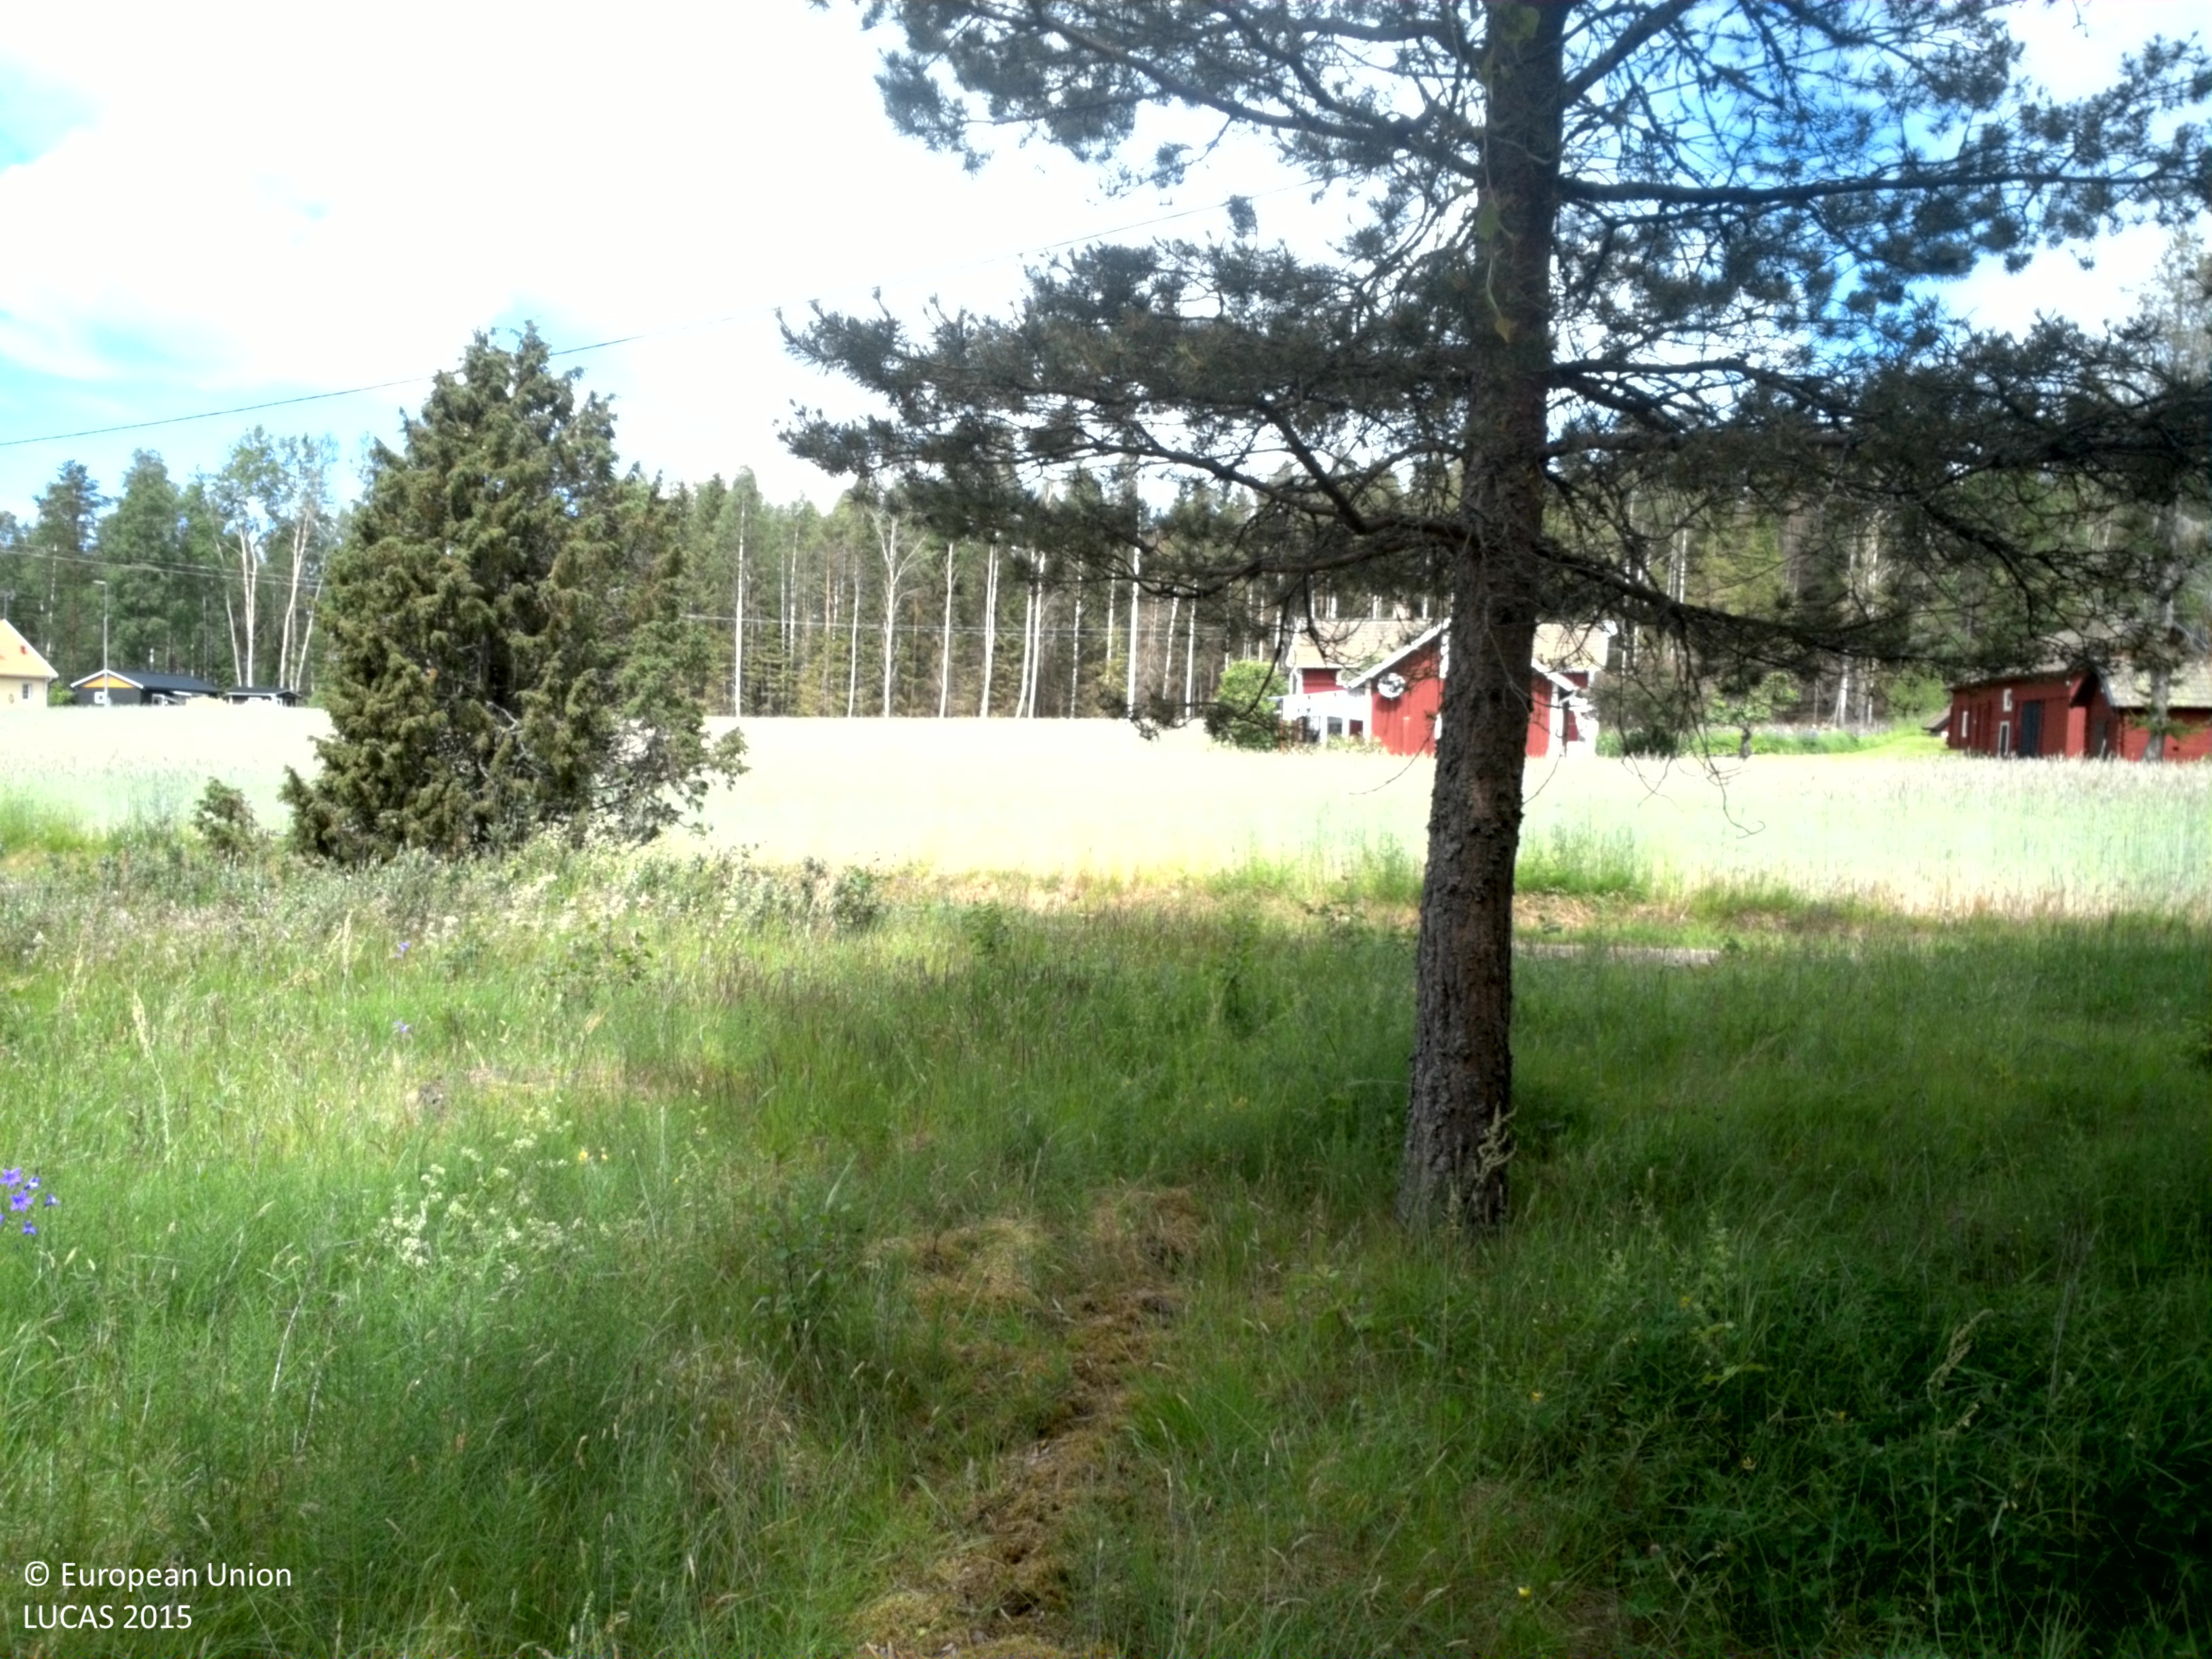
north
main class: Woodland
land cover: Pine dominated mixed woodland
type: boreal forest
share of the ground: 25 - 50 %
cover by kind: herbaceous plants 60 %, coniferous forest trees 25 %, broadleaved forest trees 15 %
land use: Forestry
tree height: > 5 m
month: July
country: SE
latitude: 60.0424
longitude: 17.0112
